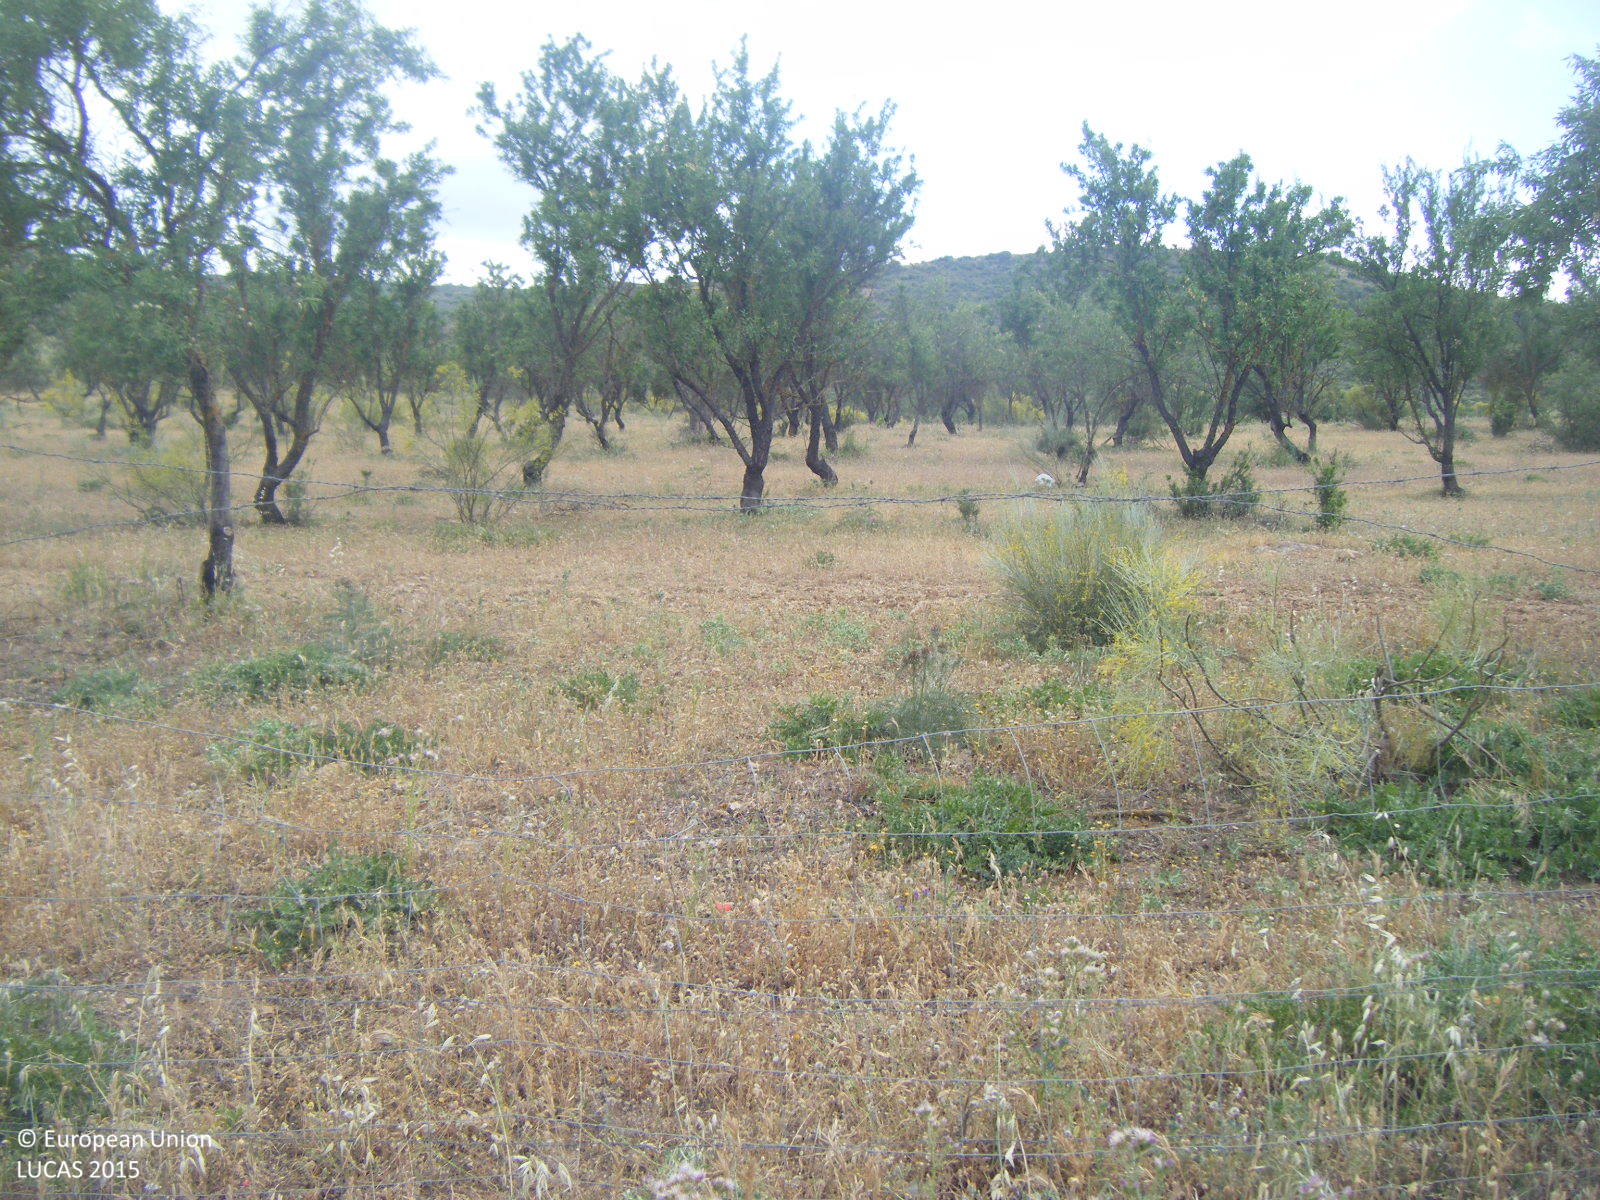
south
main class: Cropland
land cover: Nuts trees
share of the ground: 10 - 25 %
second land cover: Spontaneously vegetated surfaces
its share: > 75 %
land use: Agriculture (excluding fallow land and kitchen gardens)
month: May
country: ES
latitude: 37.0754
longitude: -4.4730
